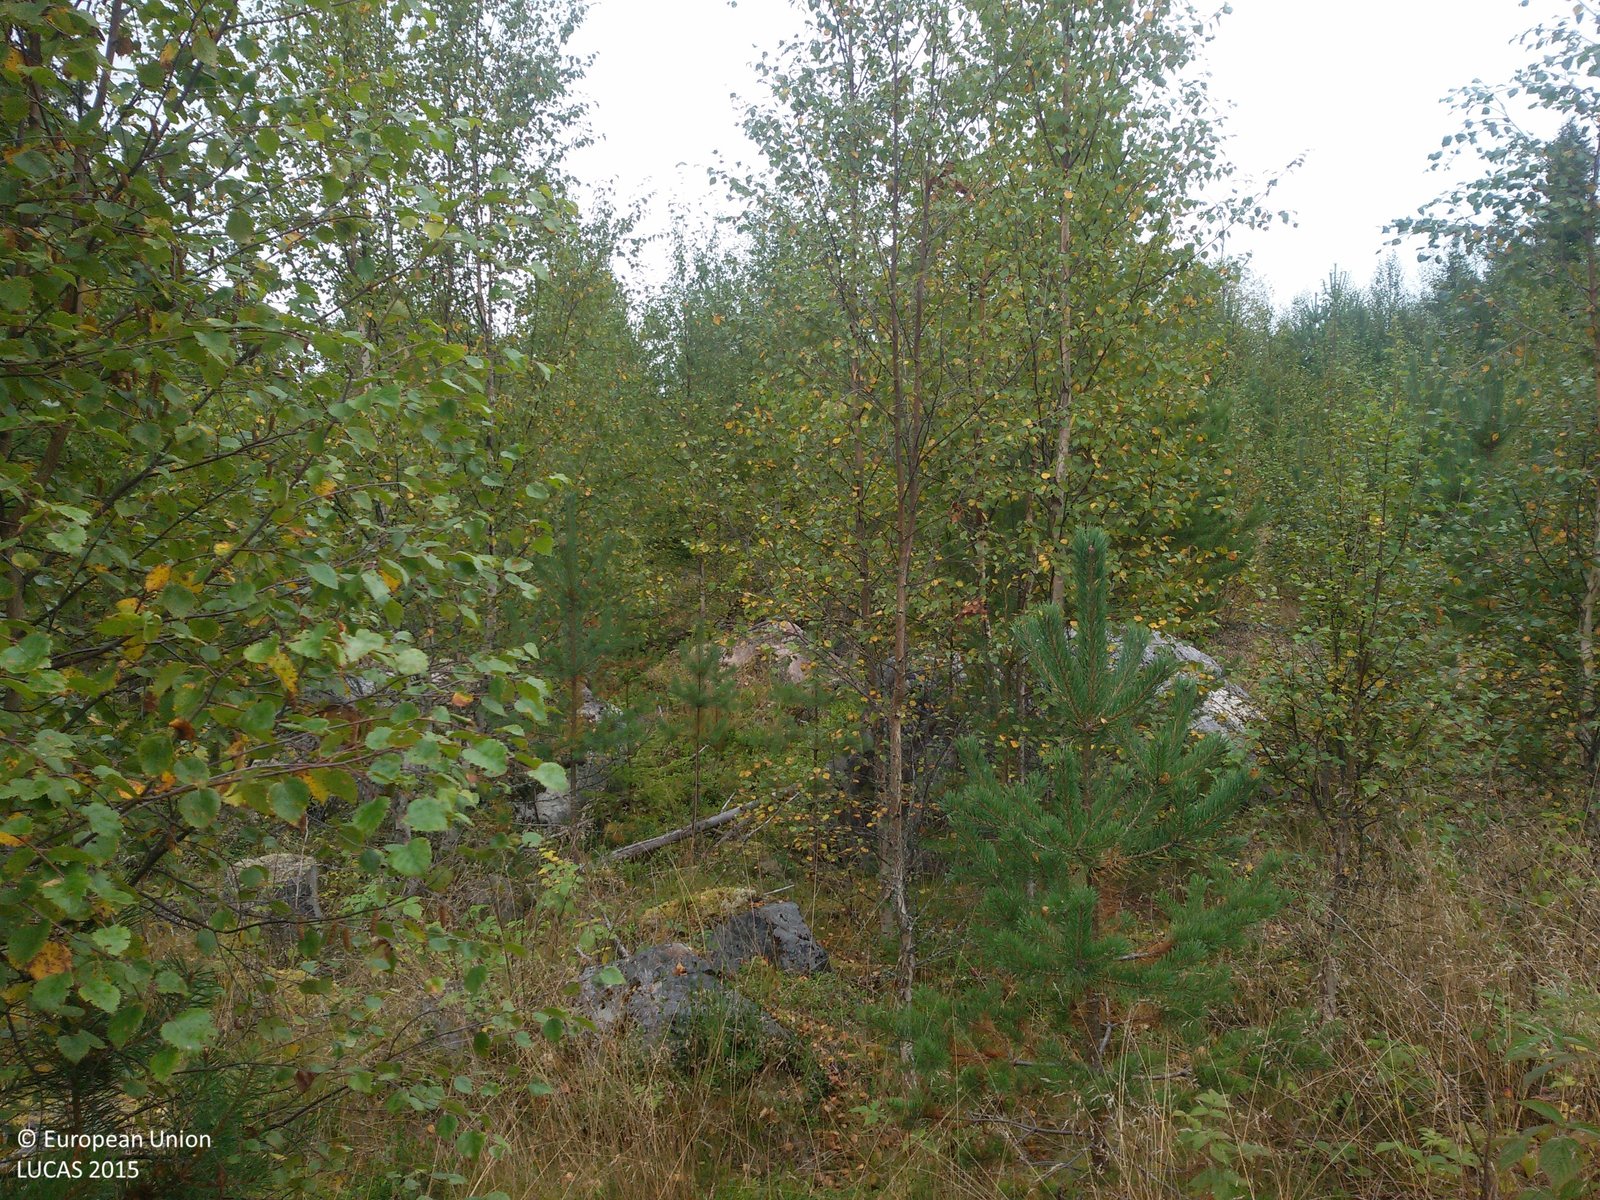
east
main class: Woodland
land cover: Pine dominated mixed woodland
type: boreal forest
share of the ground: 50 - 75 %
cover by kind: broadleaved forest trees 40 %, coniferous forest trees 30 %, herbaceous plants 20 %, lichens and mosses 10 %
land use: Forestry
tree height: < 5 m
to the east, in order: Pine dominated mixed woodland; Spontaneously vegetated surfaces; Pine dominated mixed woodland
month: September
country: SE
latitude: 60.8211
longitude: 15.3006
